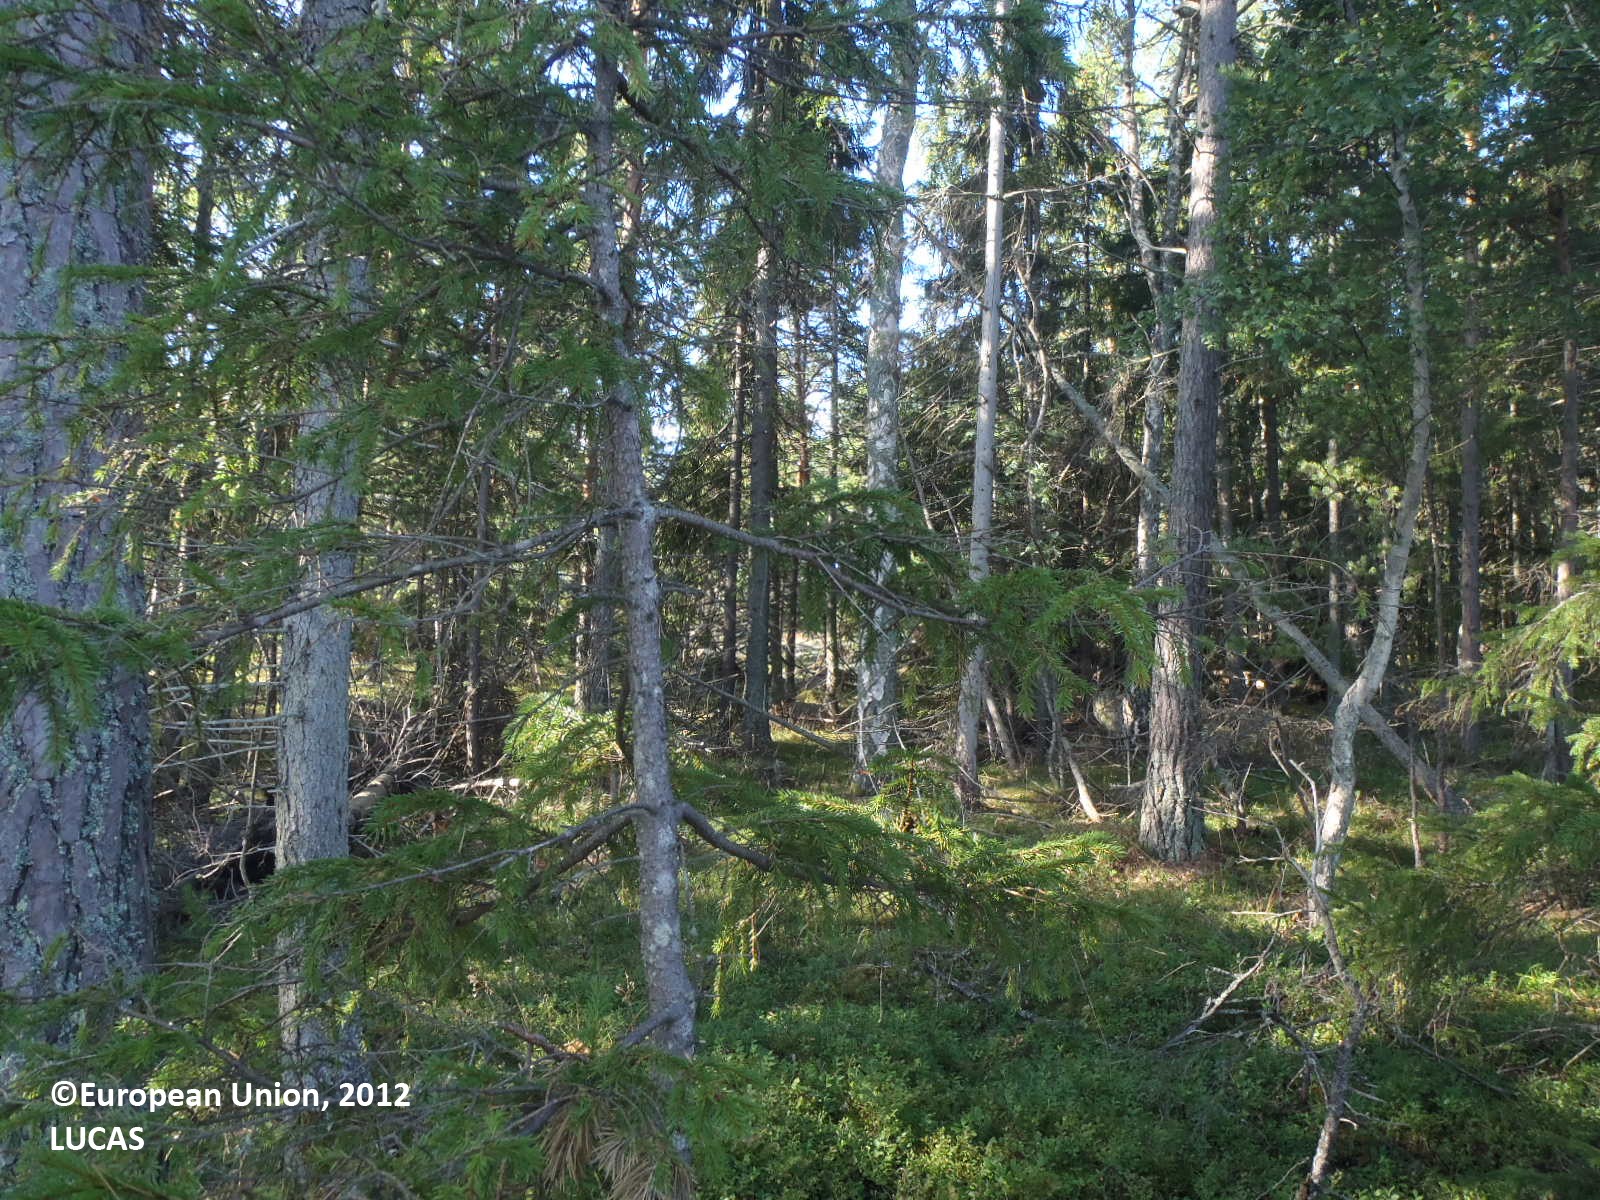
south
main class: Woodland
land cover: Pine dominated mixed woodland
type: hemiboreal forest and nemoral coniferous forest and mixed broadleaved-coniferous forest
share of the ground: 50 - 75 %
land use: Forestry
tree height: > 5 m
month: August
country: FI
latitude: 60.2222
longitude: 20.2804
